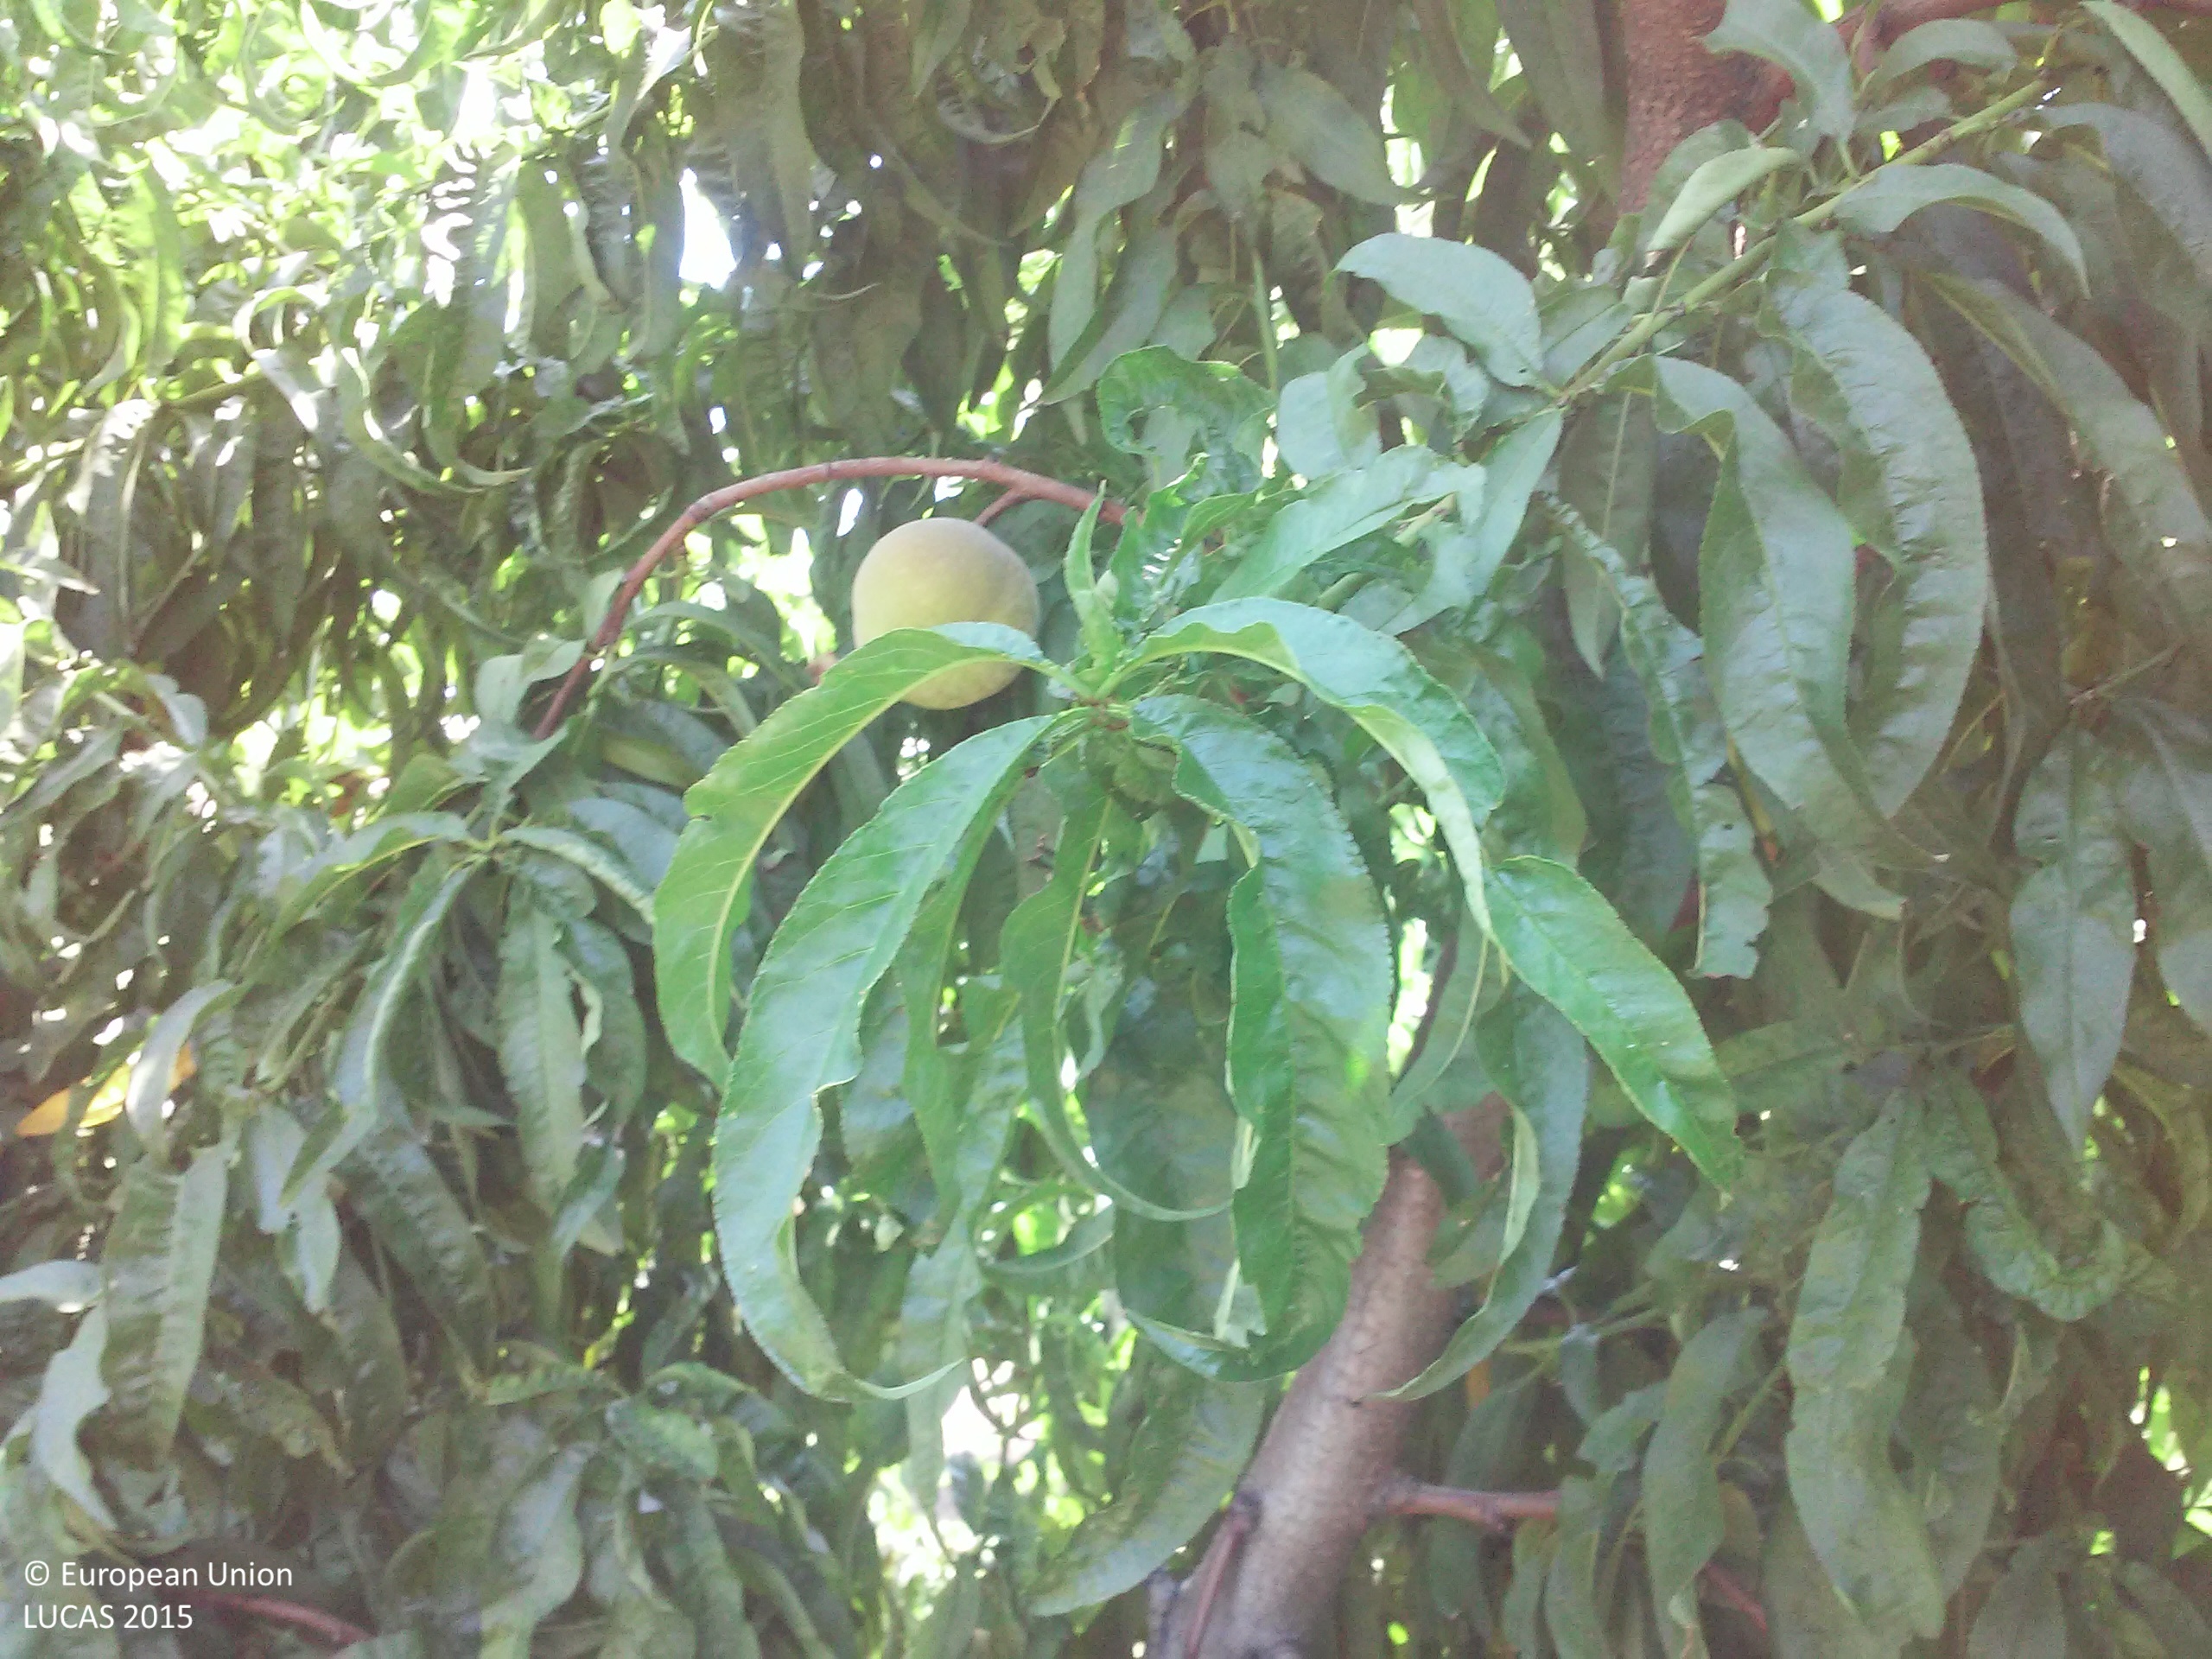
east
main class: Cropland
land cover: Other fruit trees and berries
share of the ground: 25 - 50 %
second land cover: Other bare soil
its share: > 75 %
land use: Agriculture (excluding fallow land and kitchen gardens)
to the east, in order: Other fruit trees and berries; Other bare soil; Artificial constructions in urban areas; Paved roads, cycling and walking lanes; Grass margins; Lucerne; Shrubland with sparse tree cover; Maize
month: July
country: ES
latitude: 41.6153
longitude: 0.5909
